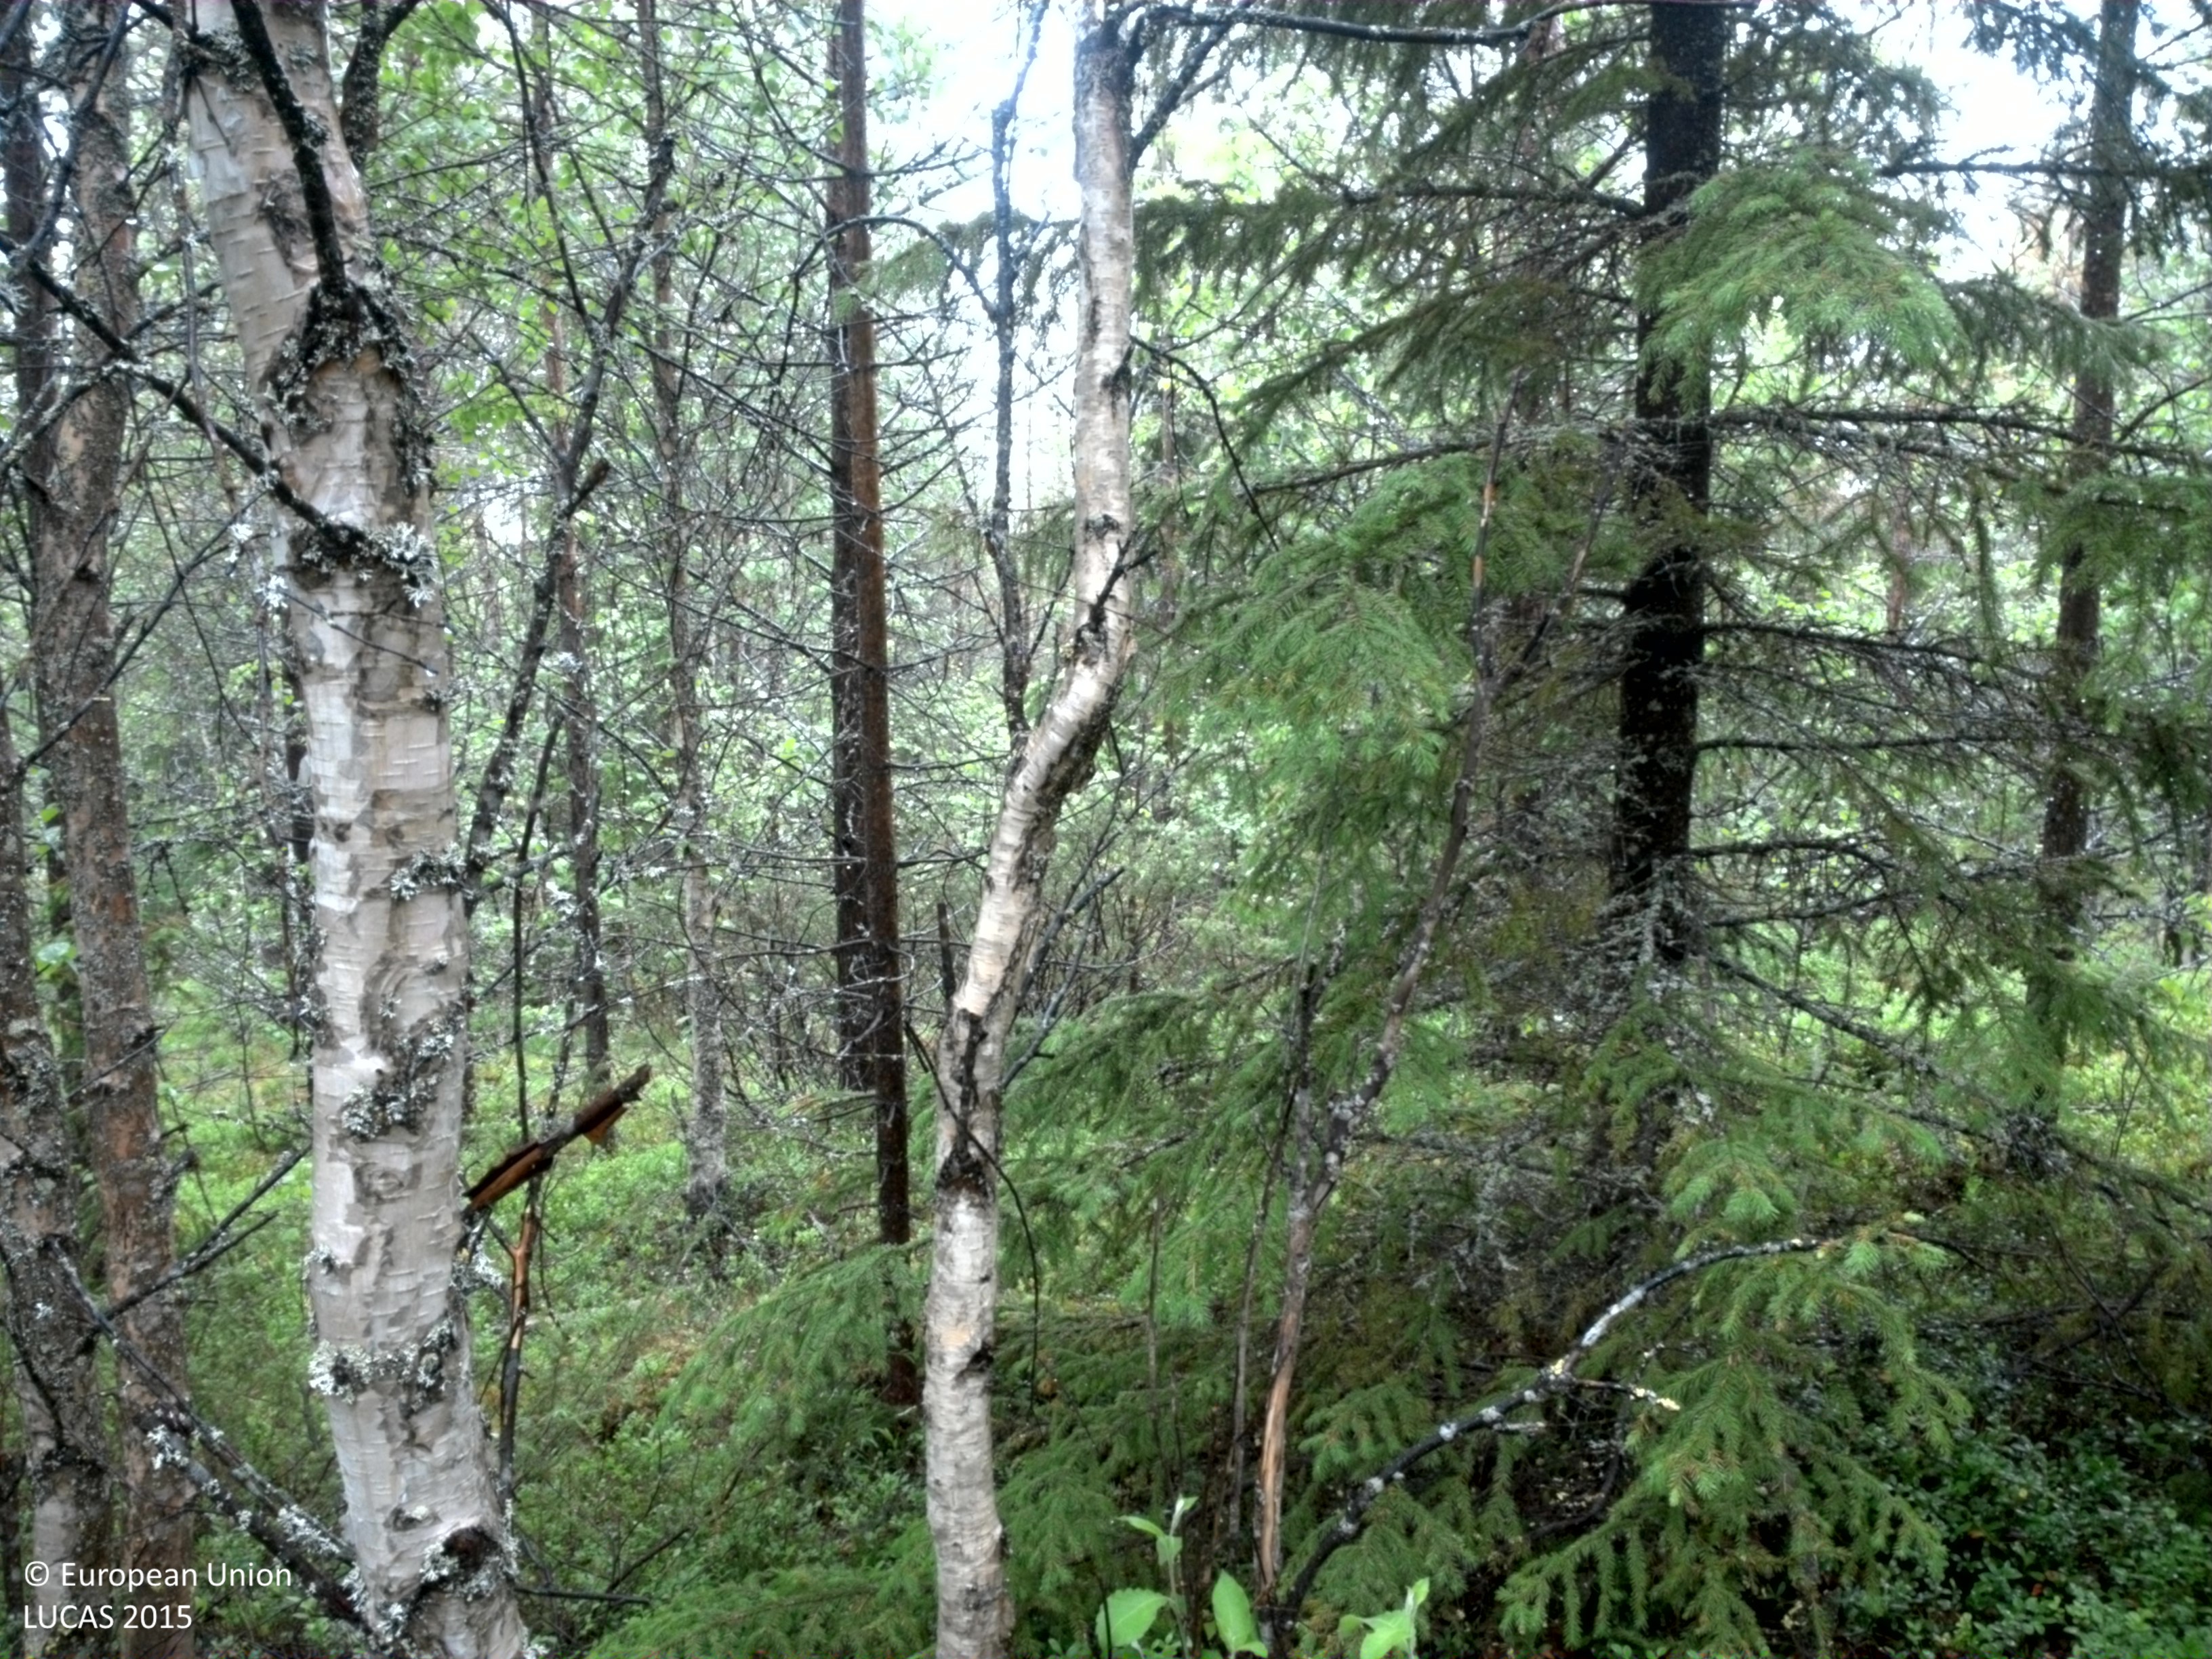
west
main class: Woodland
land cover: Other mixed woodland
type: boreal forest
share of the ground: 50 - 75 %
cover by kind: coniferous forest trees 45 %, shrubs 30 %, broadleaved forest trees 15 %, lichens and mosses 10 %
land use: Forestry
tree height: > 5 m
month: July
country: SE
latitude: 64.5892
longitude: 18.1336
